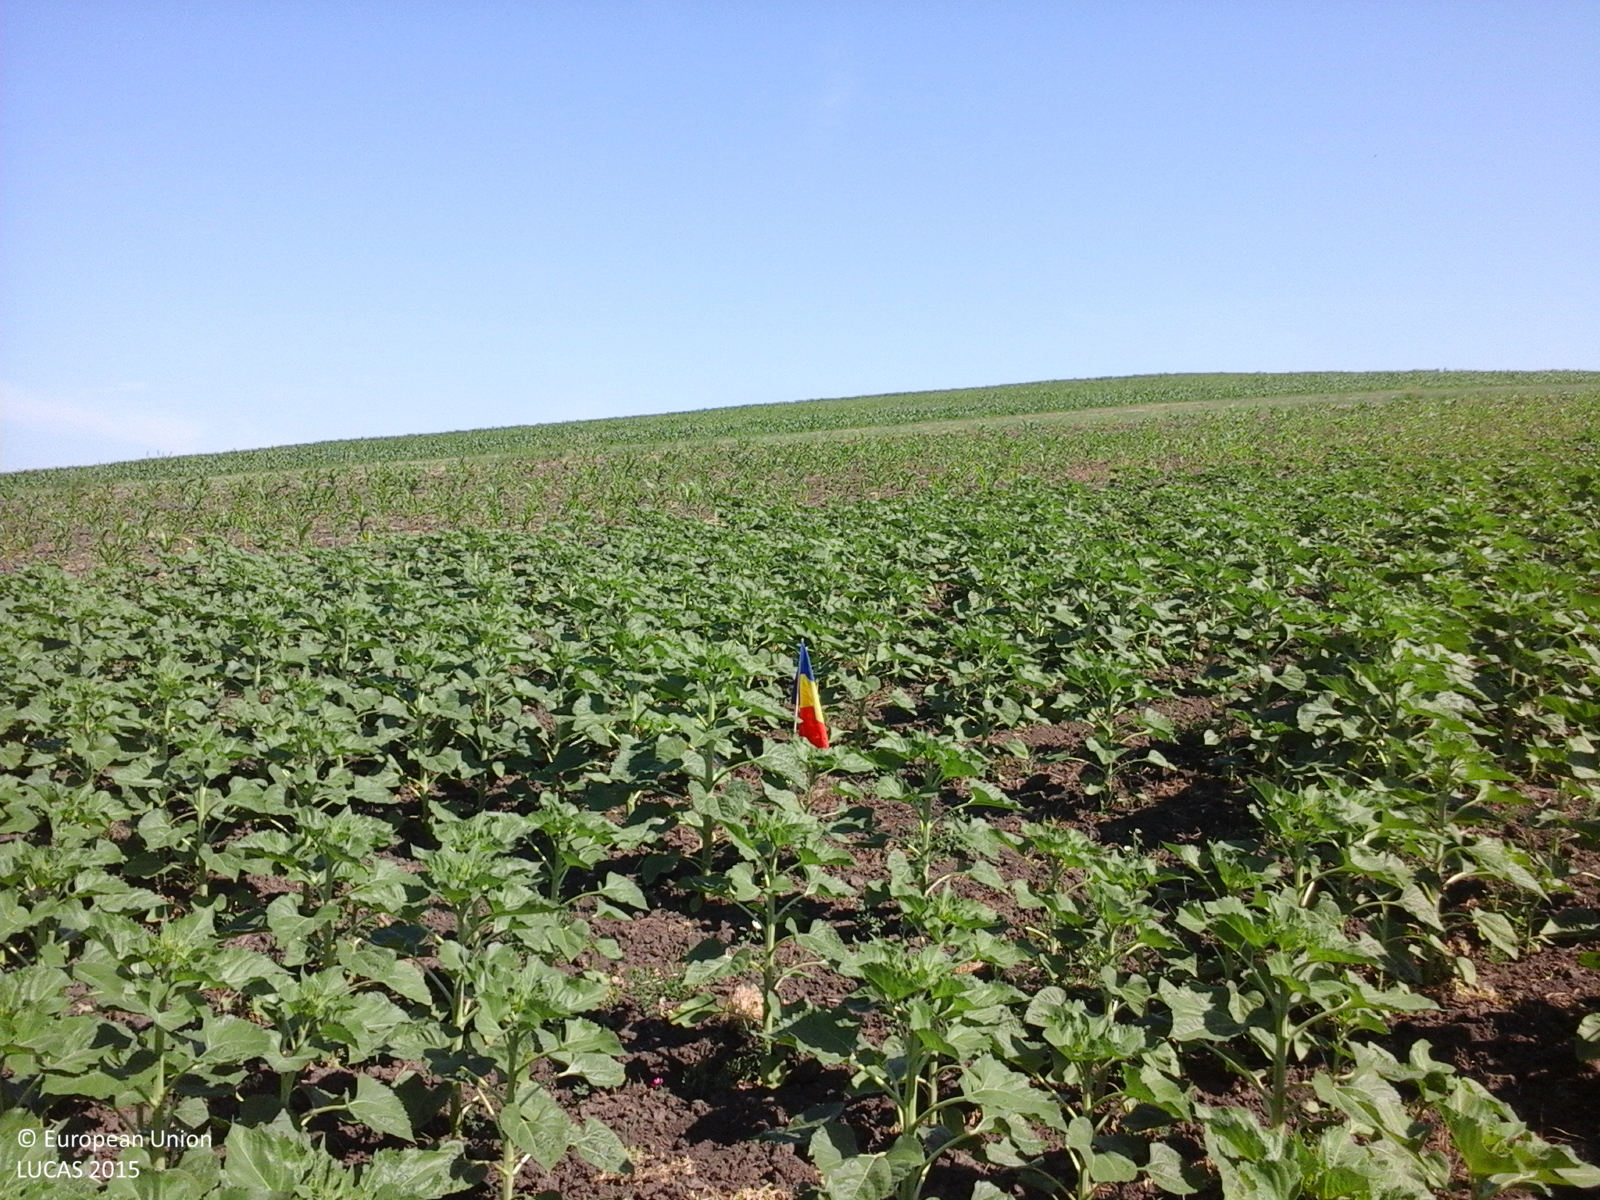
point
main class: Cropland
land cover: Sunflower
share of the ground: 50 - 75 %
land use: Agriculture (excluding fallow land and kitchen gardens)
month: June
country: RO
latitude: 47.3713
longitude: 27.0958
